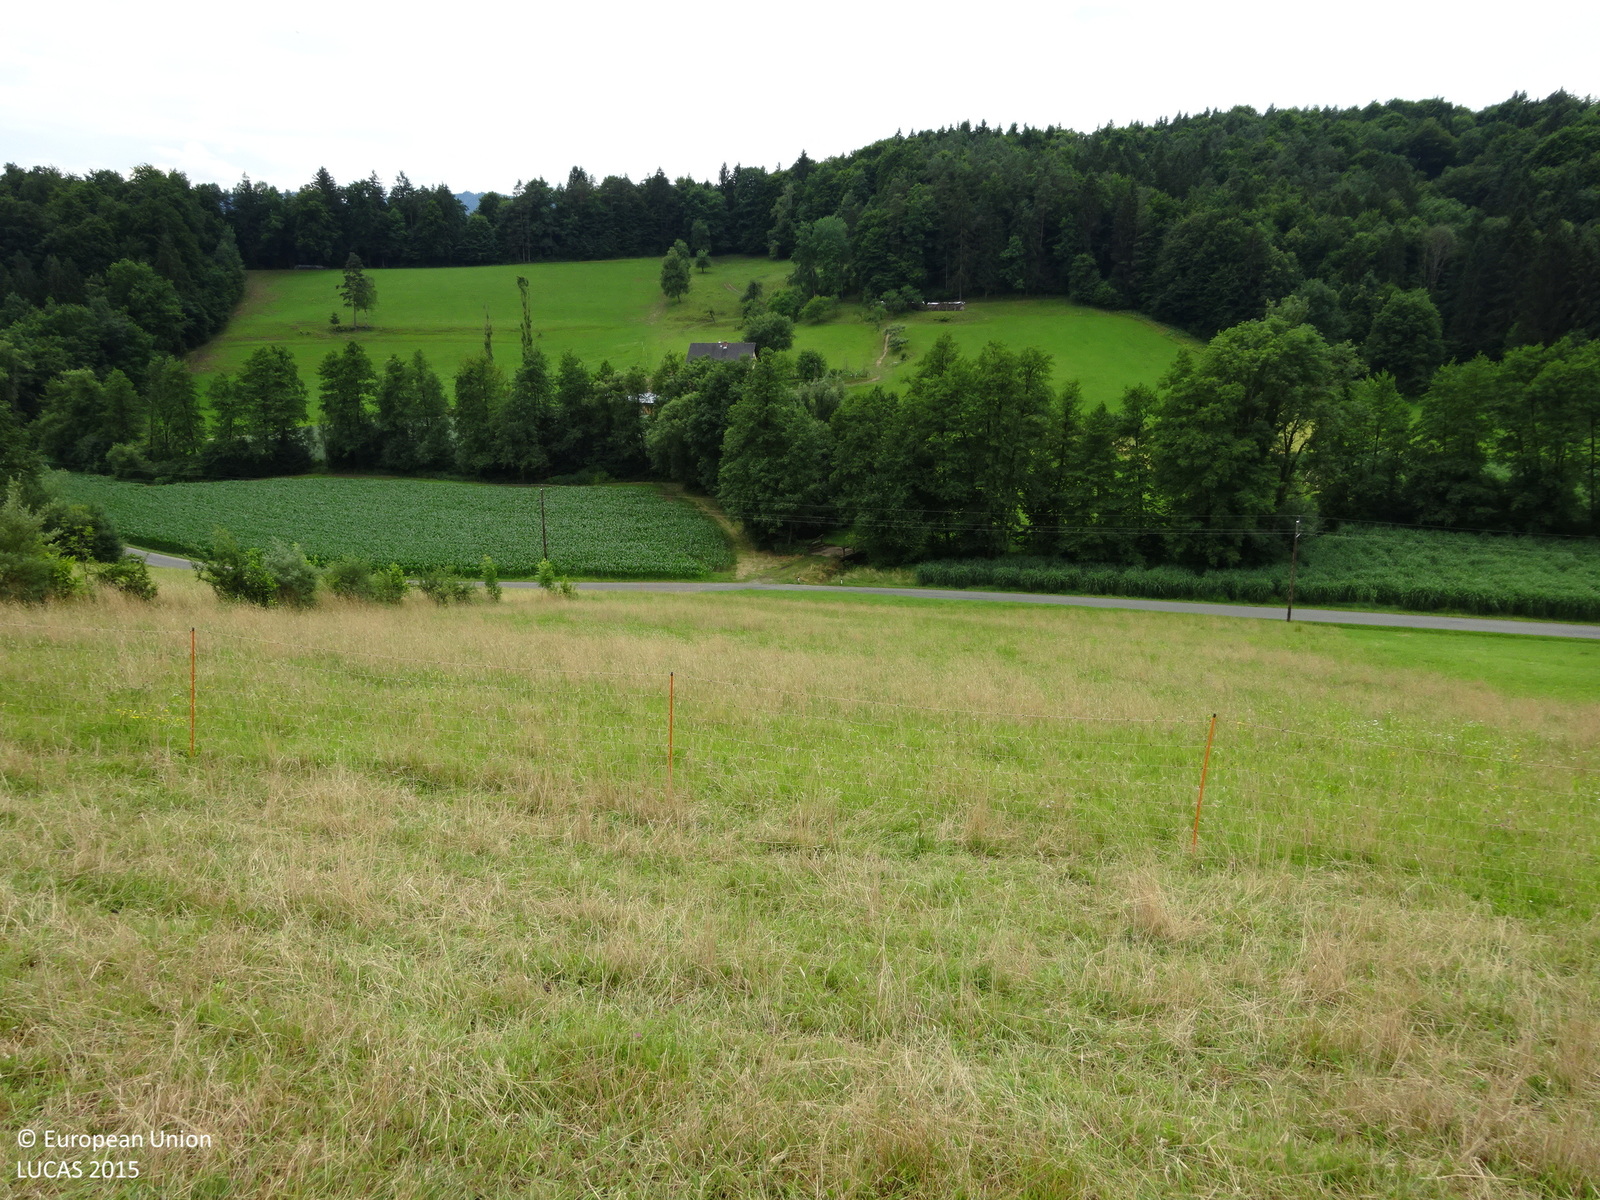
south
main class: Grassland
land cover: Grassland without tree/shrub cover
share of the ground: > 75 %
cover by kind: herbaceous plants 100 %
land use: Agriculture (excluding fallow land and kitchen gardens)
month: June
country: AT
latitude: 46.7034
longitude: 15.3744
